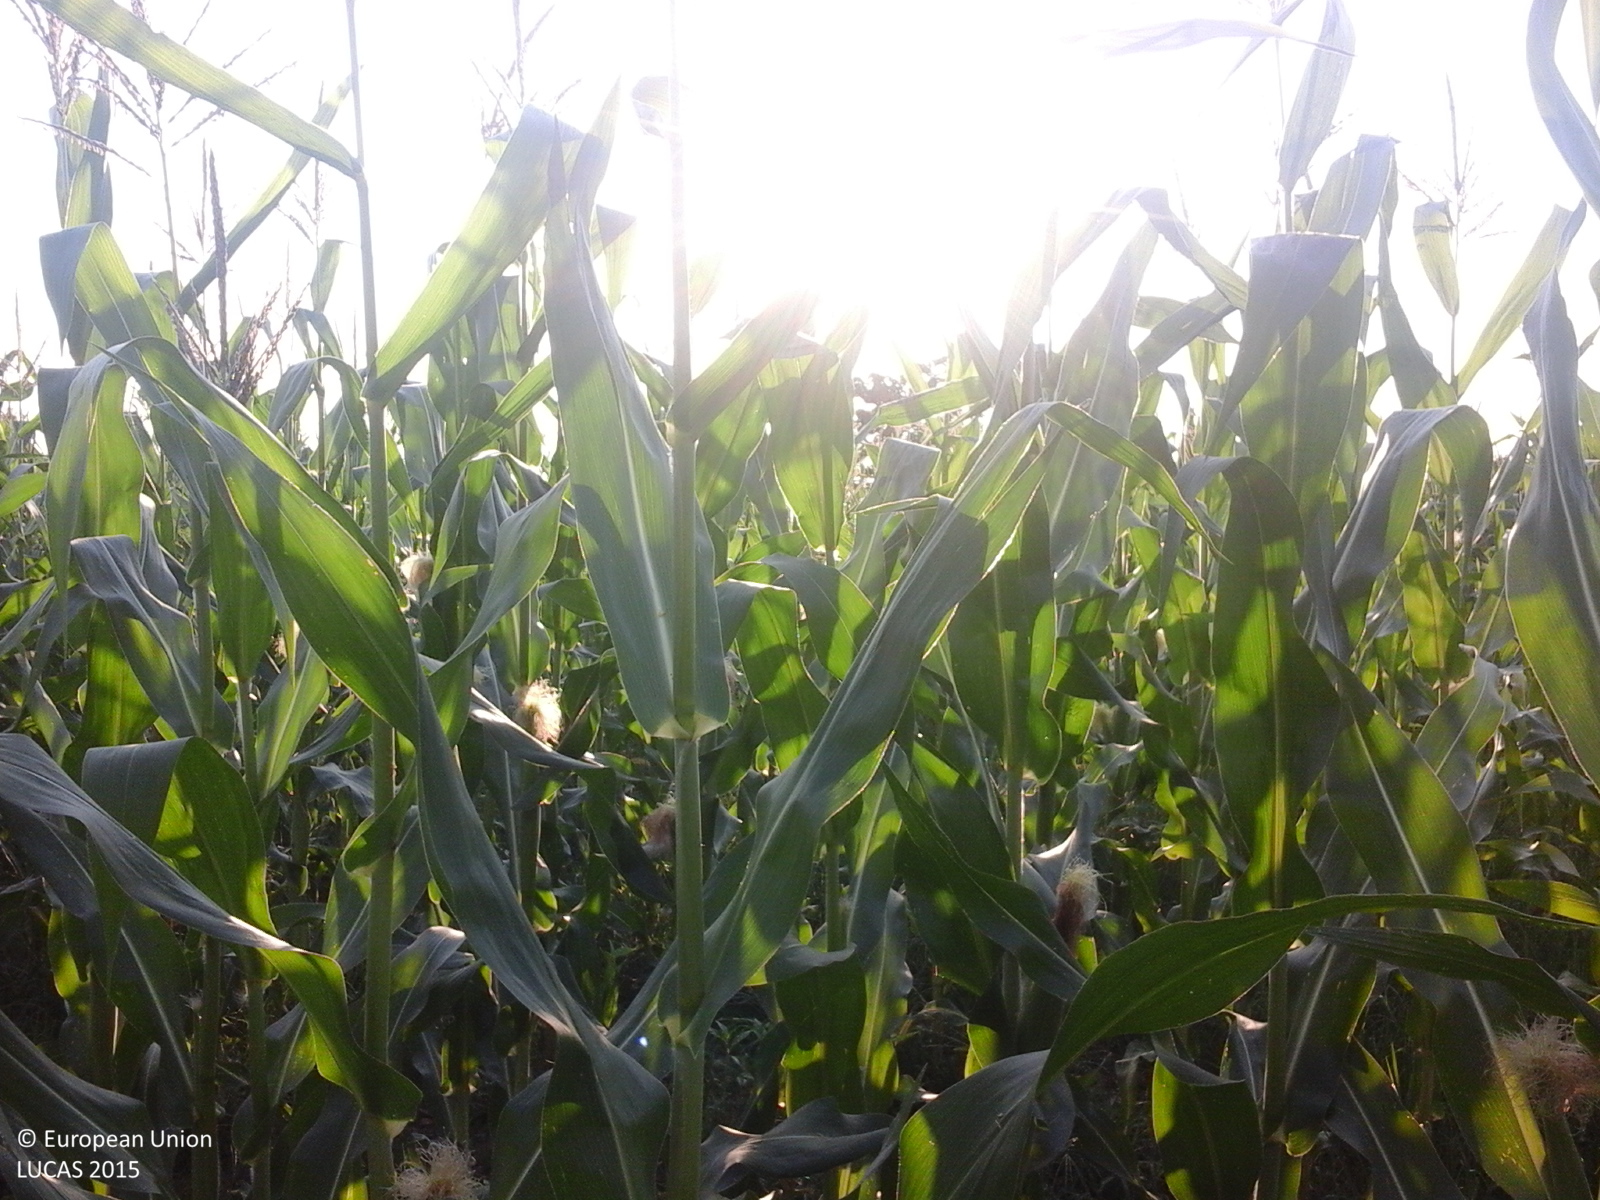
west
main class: Cropland
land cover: Maize
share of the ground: > 75 %
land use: Agriculture (excluding fallow land and kitchen gardens)
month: July
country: RO
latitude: 44.5785
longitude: 25.5721
